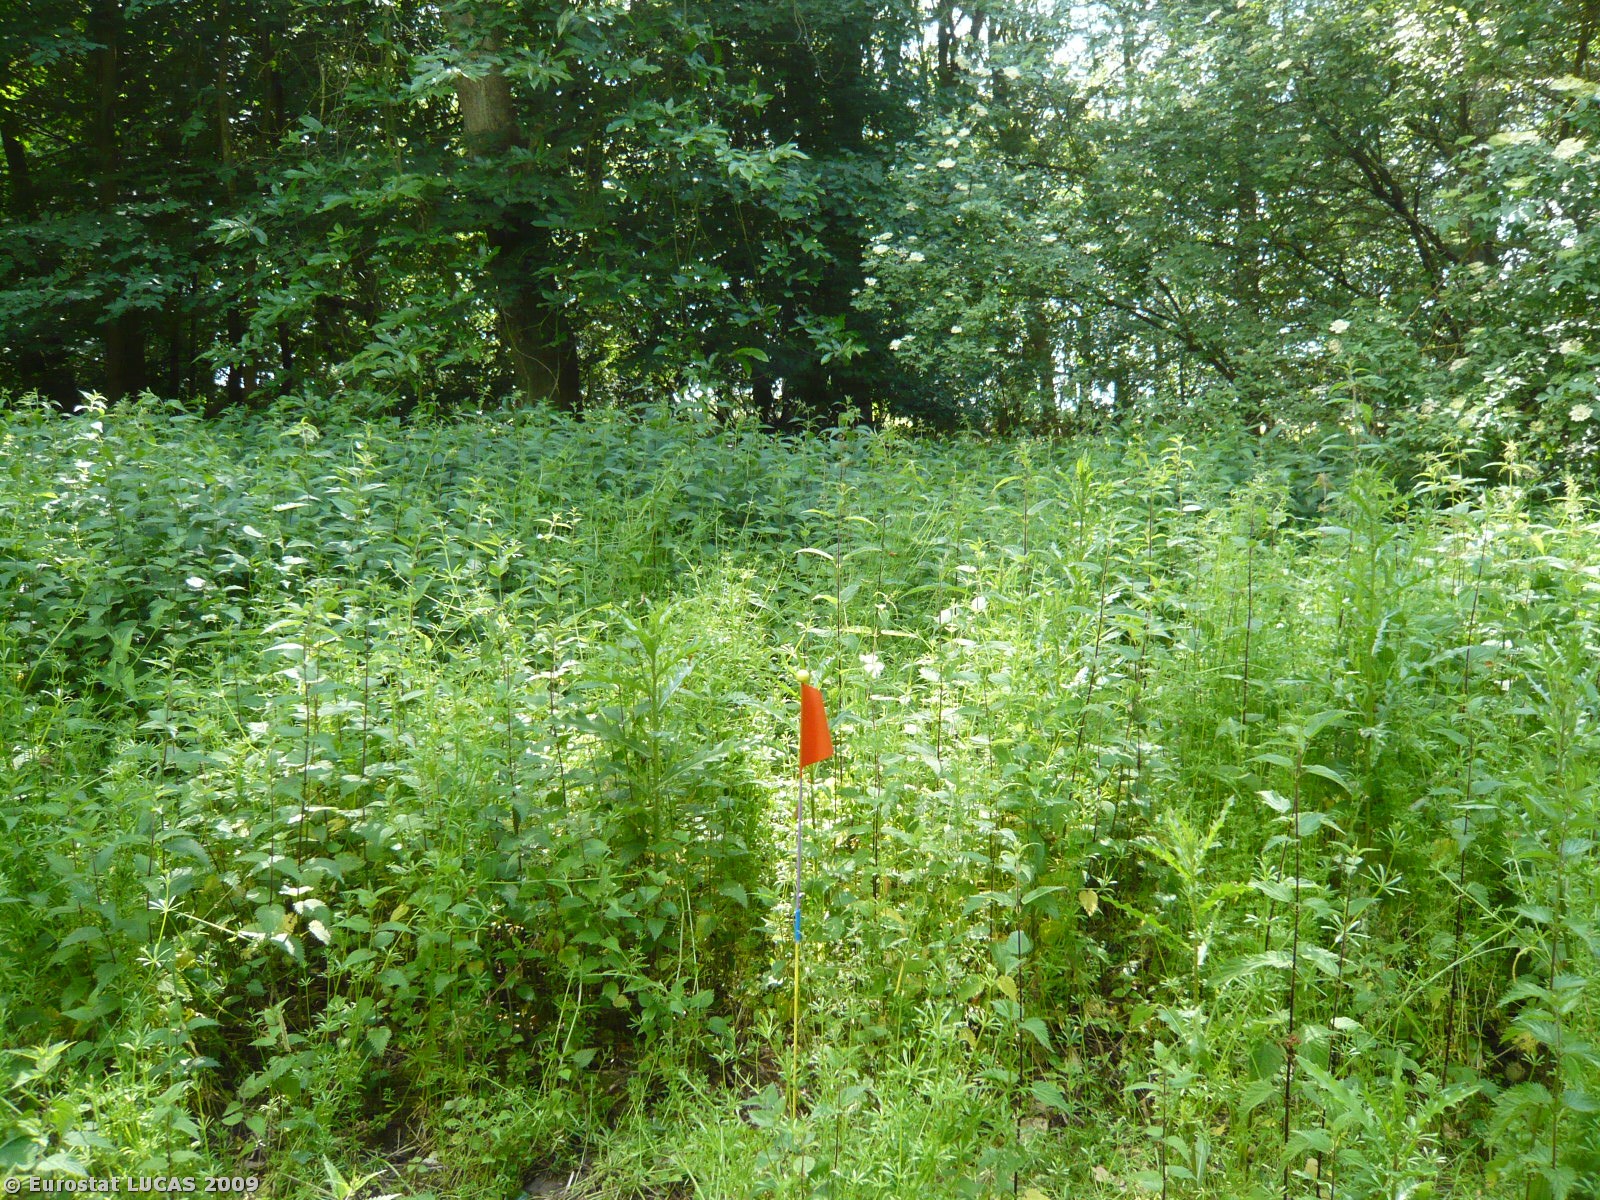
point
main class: Woodland
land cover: Broadleaved woodland
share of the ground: 50 - 75 %
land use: Residential
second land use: Amenities, museums, leisure
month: June
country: DK
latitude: 54.7404
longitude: 11.5367
